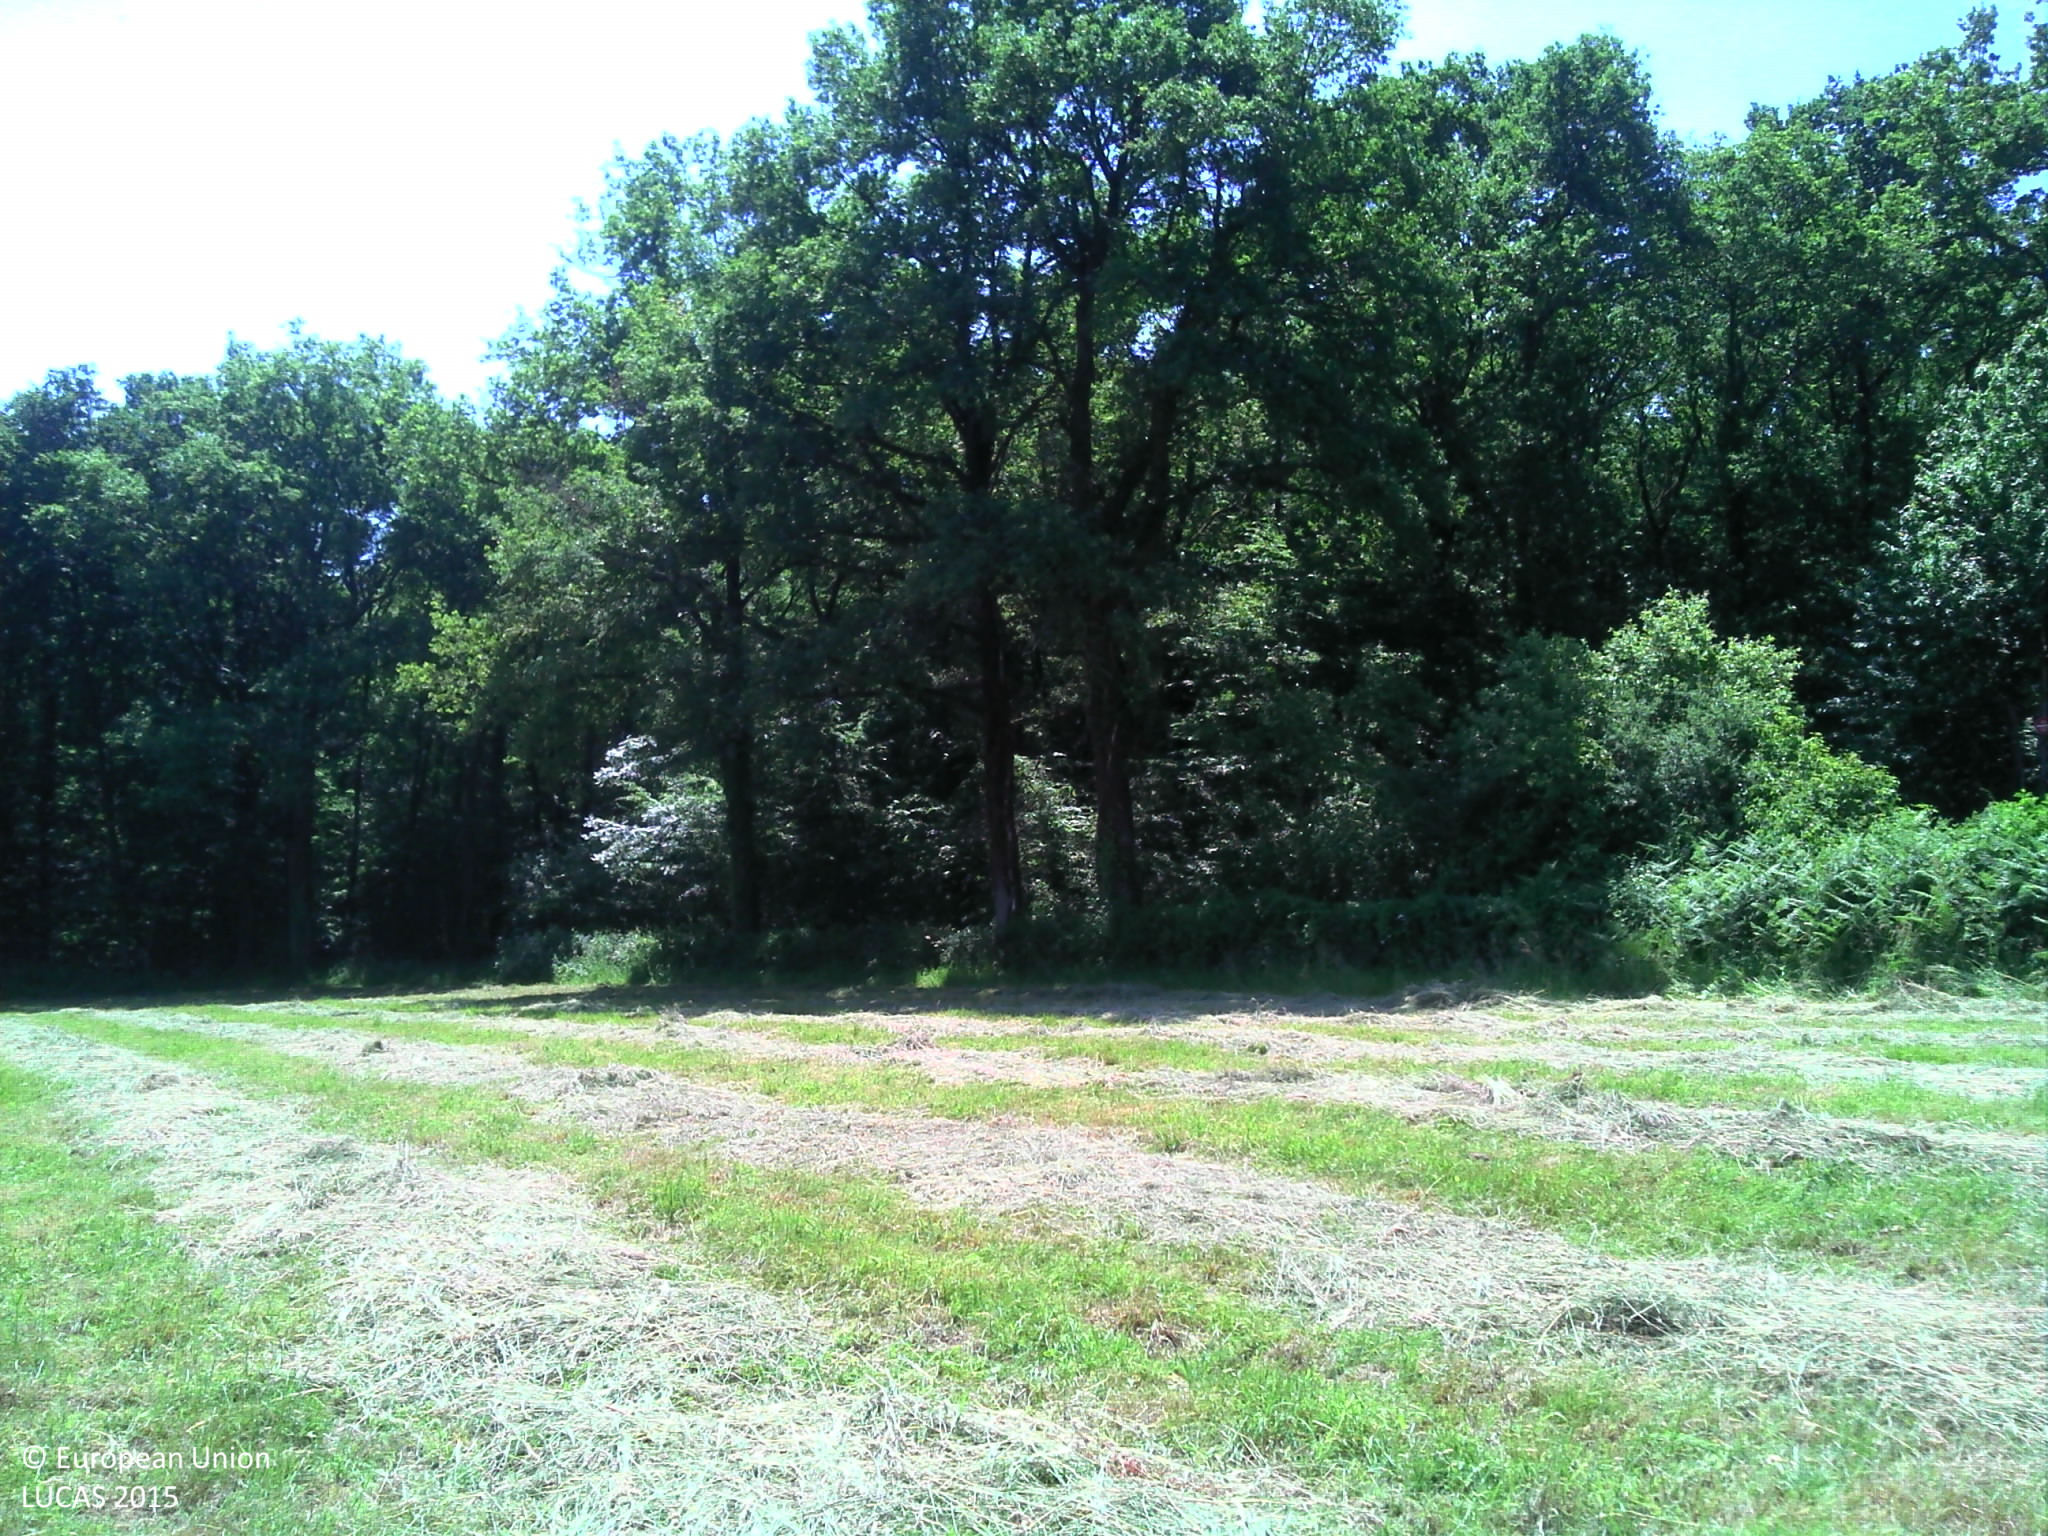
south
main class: Grassland
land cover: Grassland without tree/shrub cover
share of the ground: > 75 %
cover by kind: herbaceous plants 100 %
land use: Agriculture (excluding fallow land and kitchen gardens)
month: June
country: FR
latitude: 46.3551
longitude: 2.7058
